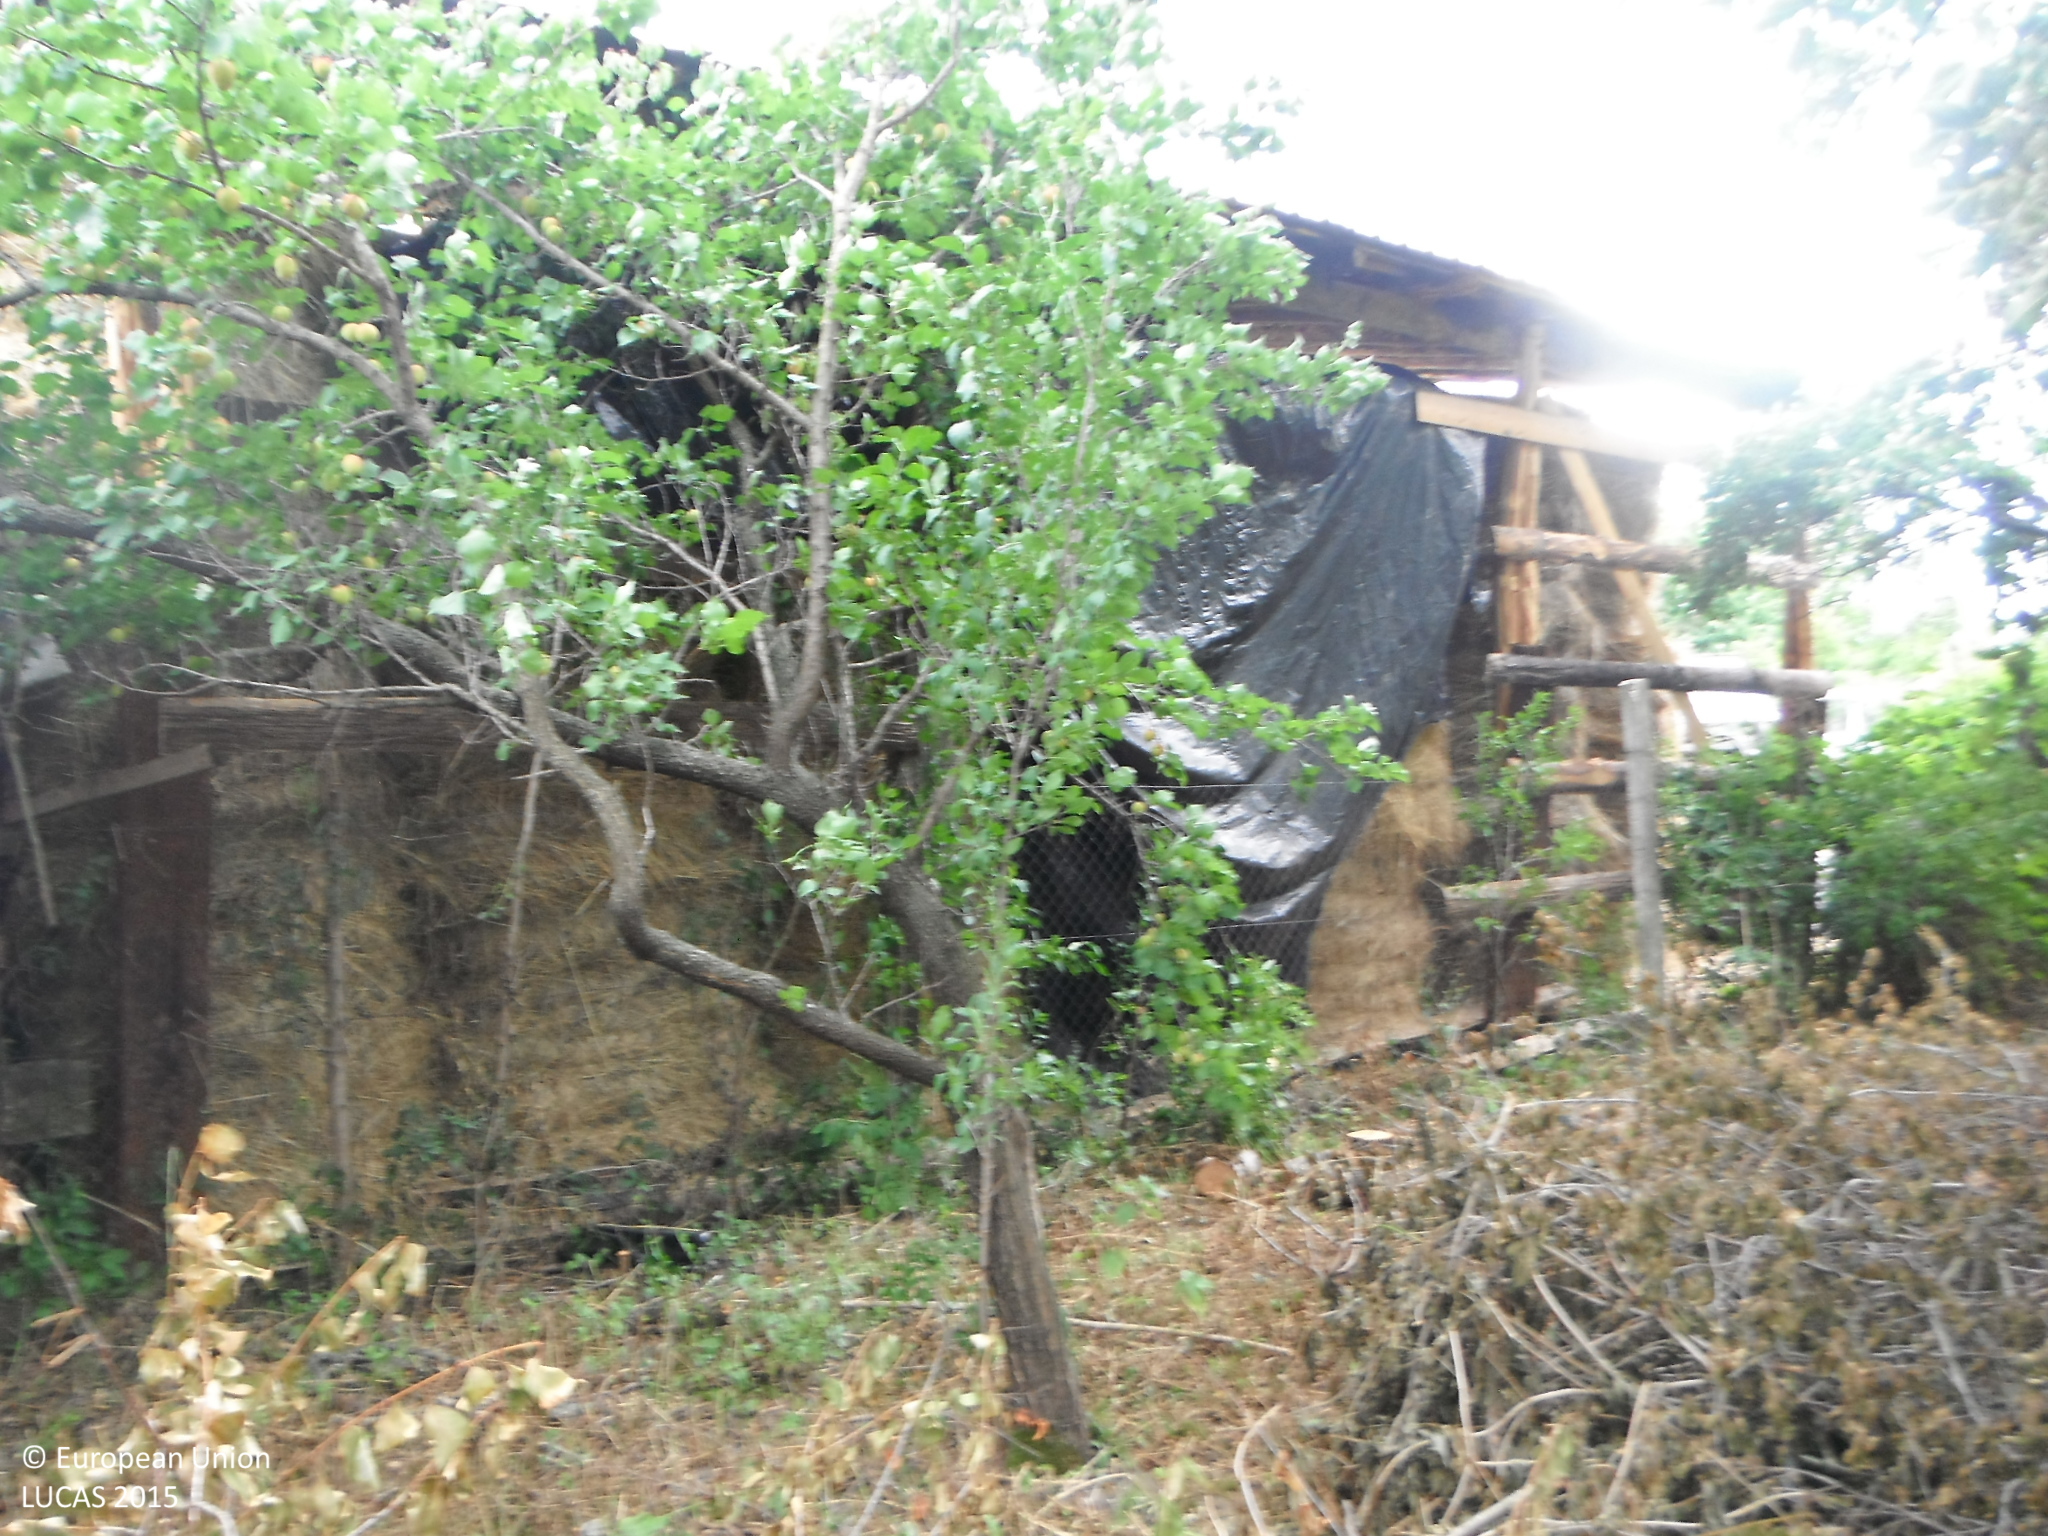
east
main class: Cropland
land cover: Other fruit trees and berries
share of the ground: 10 - 25 %
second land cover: Grassland without tree/shrub cover
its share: > 75 %
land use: Kitchen garden
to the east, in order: Other fruit trees and berries; Grassland without tree/shrub cover; Artificial constructions in urban areas; Grassland without tree/shrub cover; Abandoned hedges; Spontaneously vegetated surfaces; Inland fresh running water; Broadleaved woodland; Inland fresh running water; Broadleaved woodland; Inland fresh running water; Shrubland without tree cover; Grass margins; Tracks; Arable land (only in case pi)
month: July
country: SK
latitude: 48.4844
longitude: 18.1184
